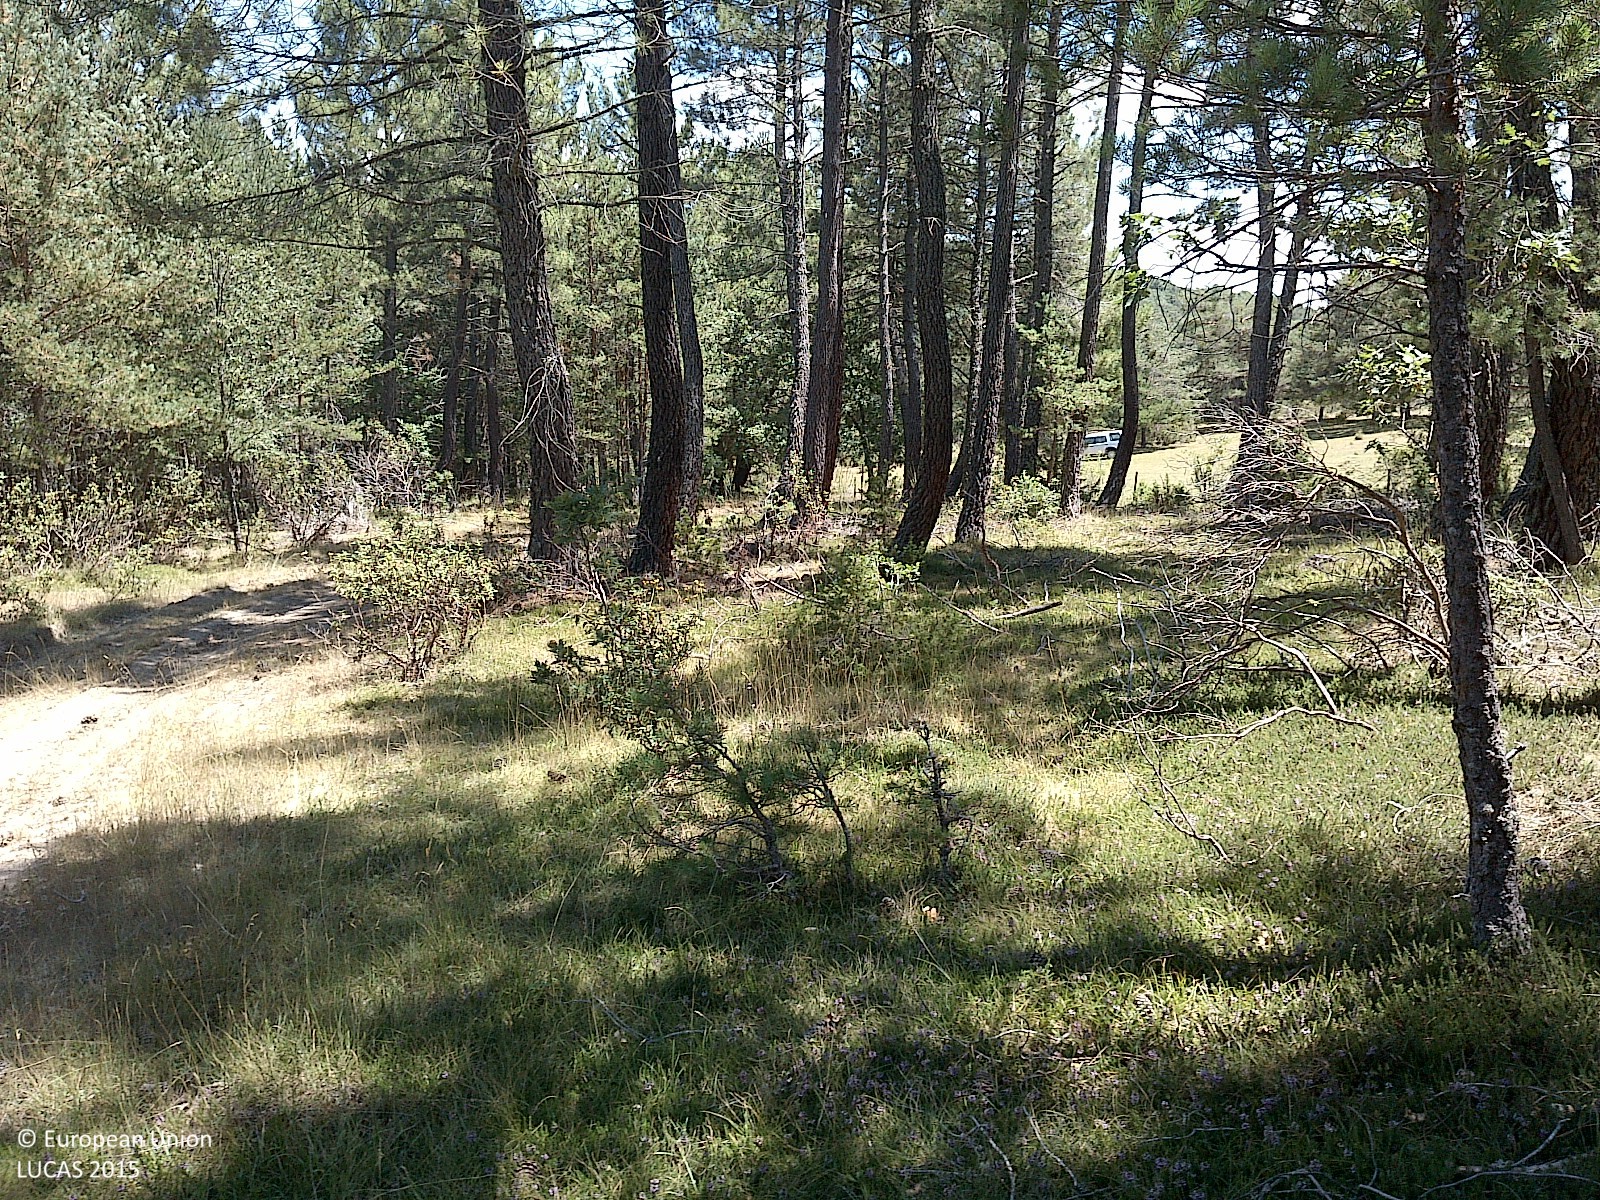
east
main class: Woodland
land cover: Pine dominated coniferous woodland
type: coniferous forest of the mediterranean region
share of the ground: > 75 %
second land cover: Grassland without tree/shrub cover
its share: 50 - 75 %
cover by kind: coniferous forest trees 80 %, herbaceous plants 15 %, shrubs 5 %
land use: Forestry
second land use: Agriculture (excluding fallow land and kitchen gardens)
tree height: > 5 m
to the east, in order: Pine dominated coniferous woodland; Grassland without tree/shrub cover; Tracks; Pine dominated coniferous woodland; Fences; Grassland with sparse tree/shrub cover; Pine dominated coniferous woodland; Shrubland with sparse tree cover; Grassland without tree/shrub cover; Grassland with sparse tree/shrub cover
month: July
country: ES
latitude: 41.8812
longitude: -3.1708
